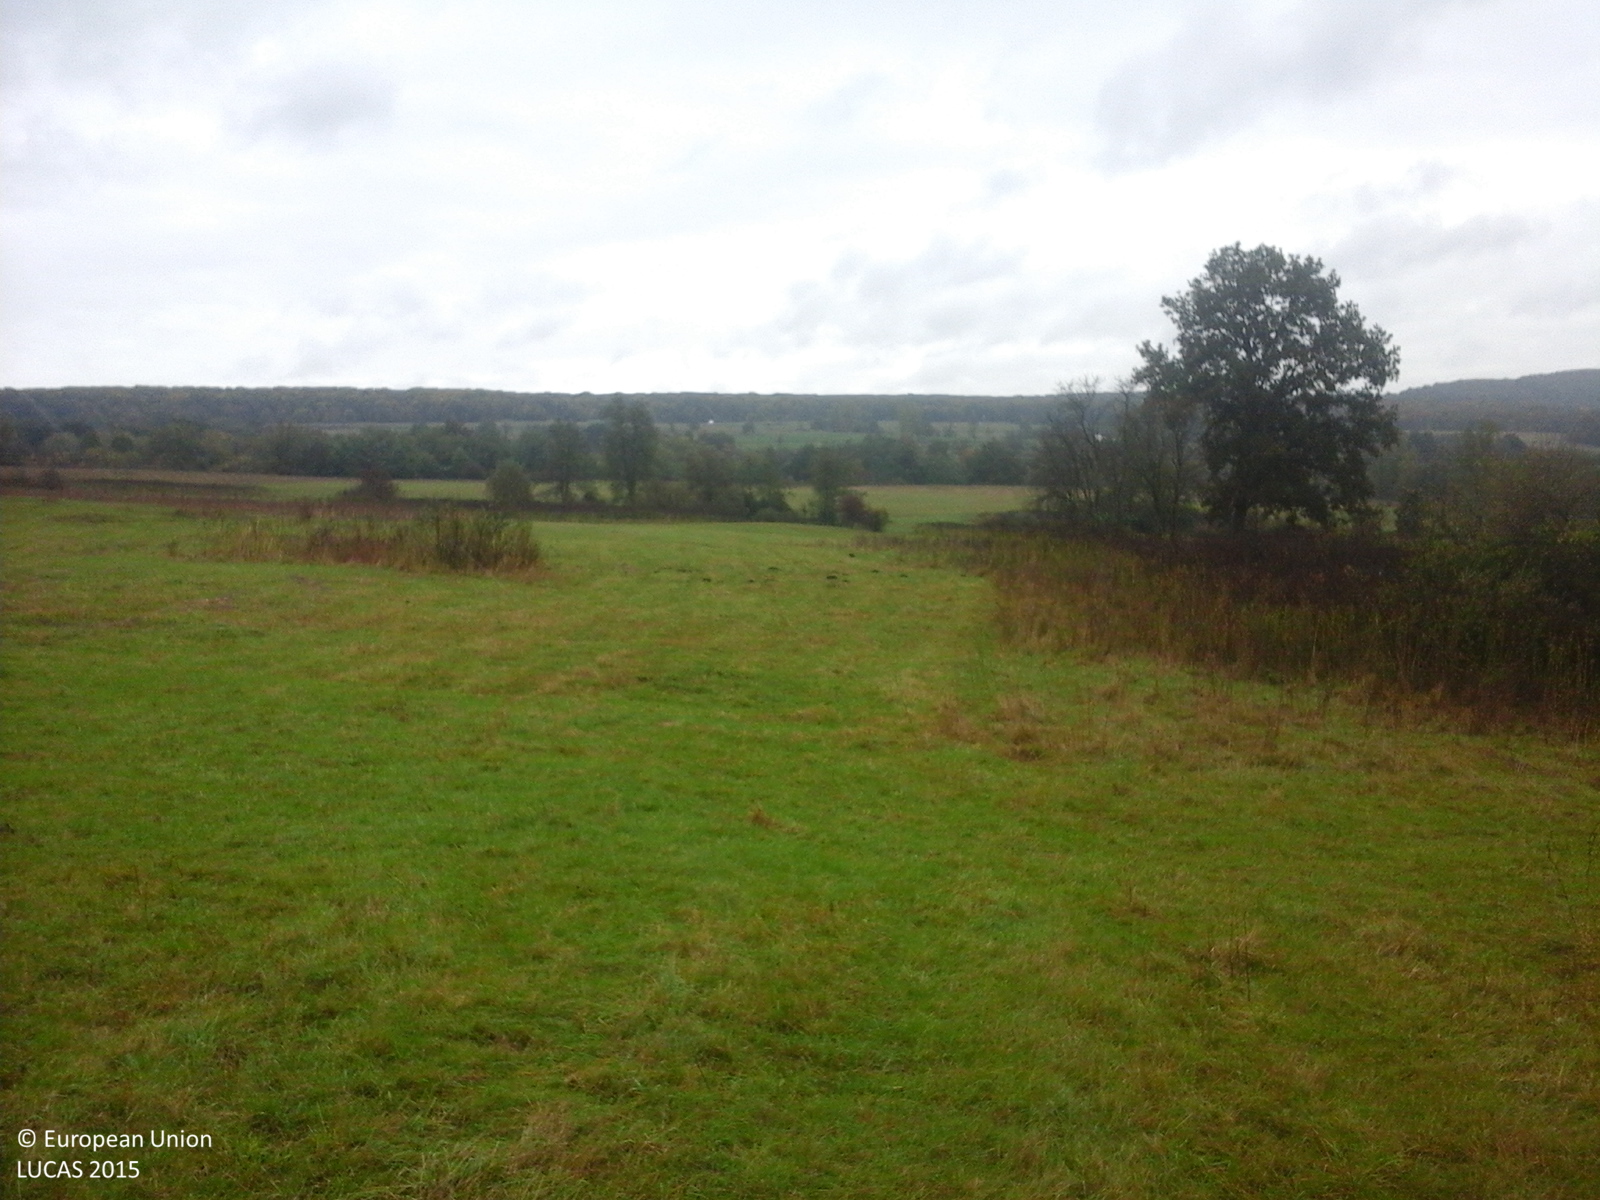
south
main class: Grassland
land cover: Grassland without tree/shrub cover
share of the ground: > 75 %
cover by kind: herbaceous plants 100 %
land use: Agriculture (excluding fallow land and kitchen gardens)
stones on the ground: < 10 %
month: October
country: RO
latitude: 45.8305
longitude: 24.6445
